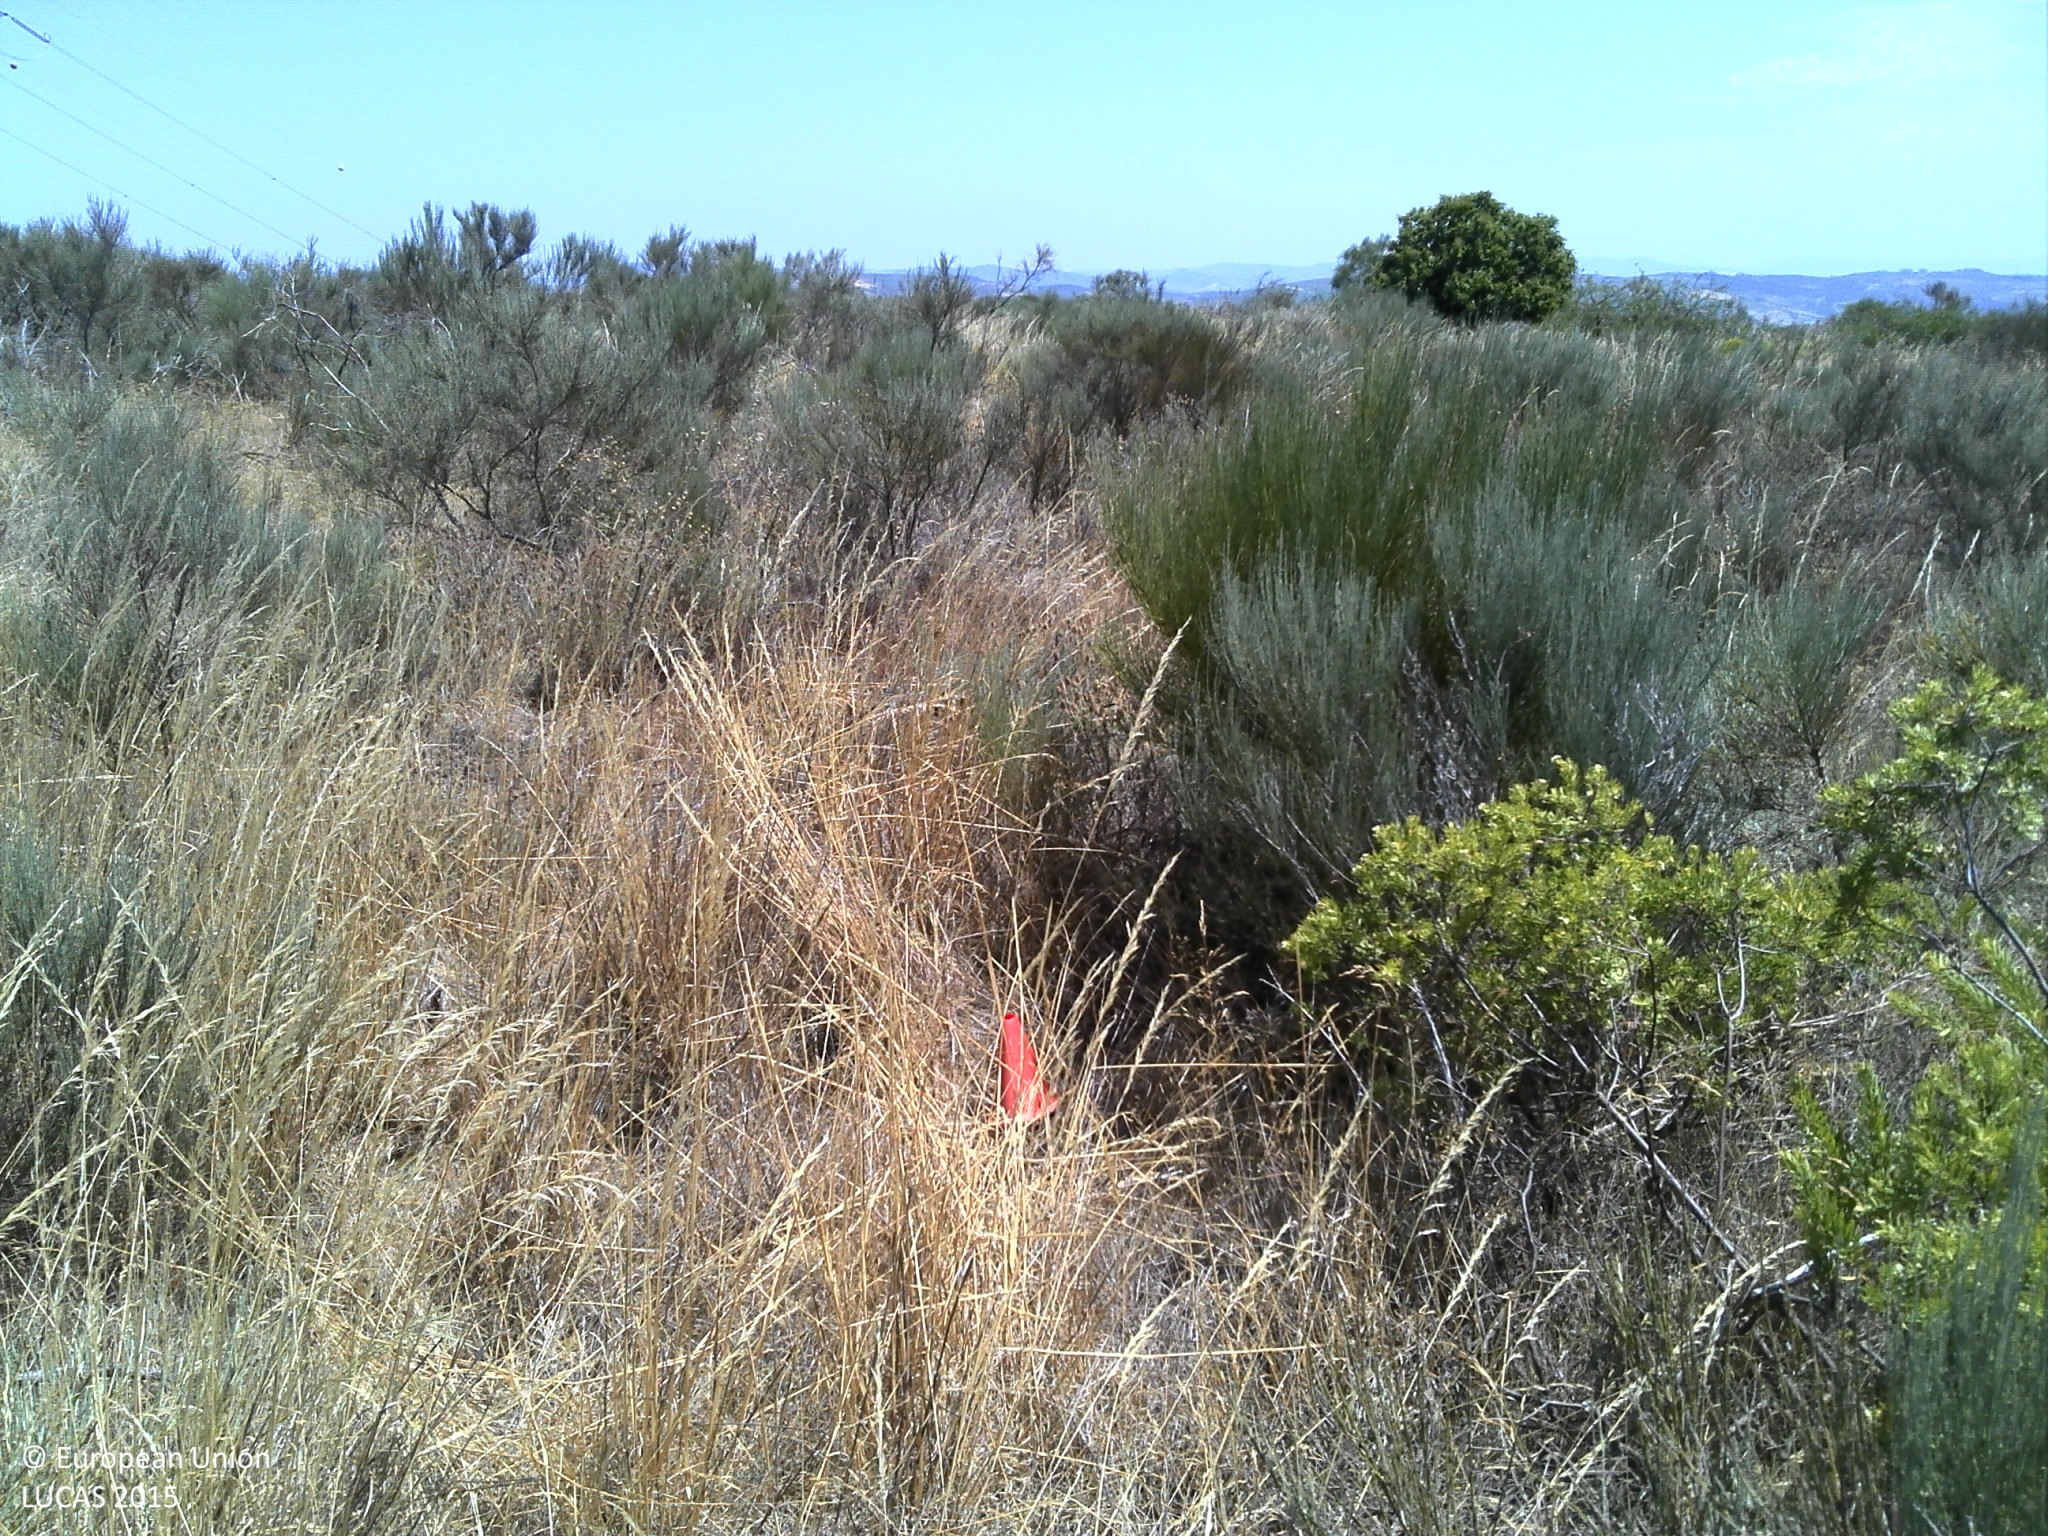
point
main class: Shrubland
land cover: Shrubland without tree cover
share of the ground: 50 - 75 %
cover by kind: shrubs 65 %, herbaceous plants 35 %
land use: Semi-natural and natural areas not in use
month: July
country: PT
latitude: 41.1035
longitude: -7.4688
